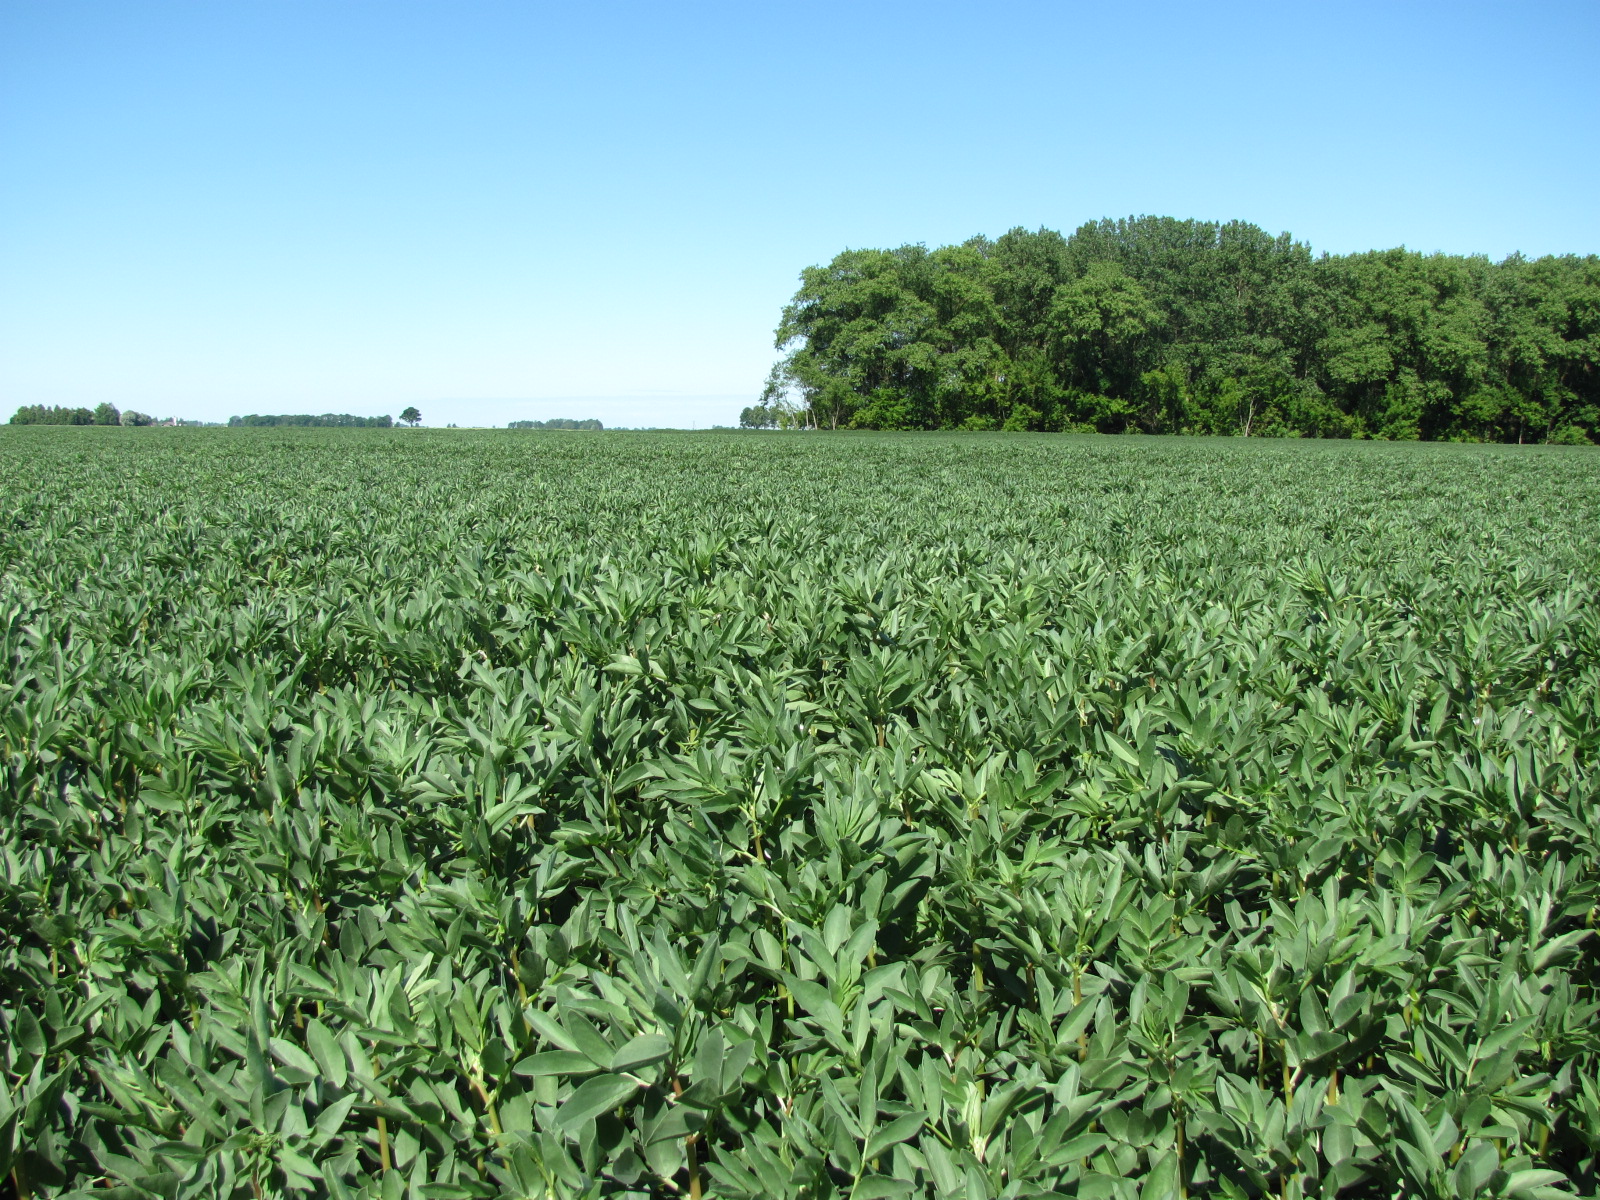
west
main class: Cropland
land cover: Dry pulses
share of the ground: > 75 %
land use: Agriculture (excluding fallow land and kitchen gardens)
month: July
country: LV
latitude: 56.4685
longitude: 23.8964
